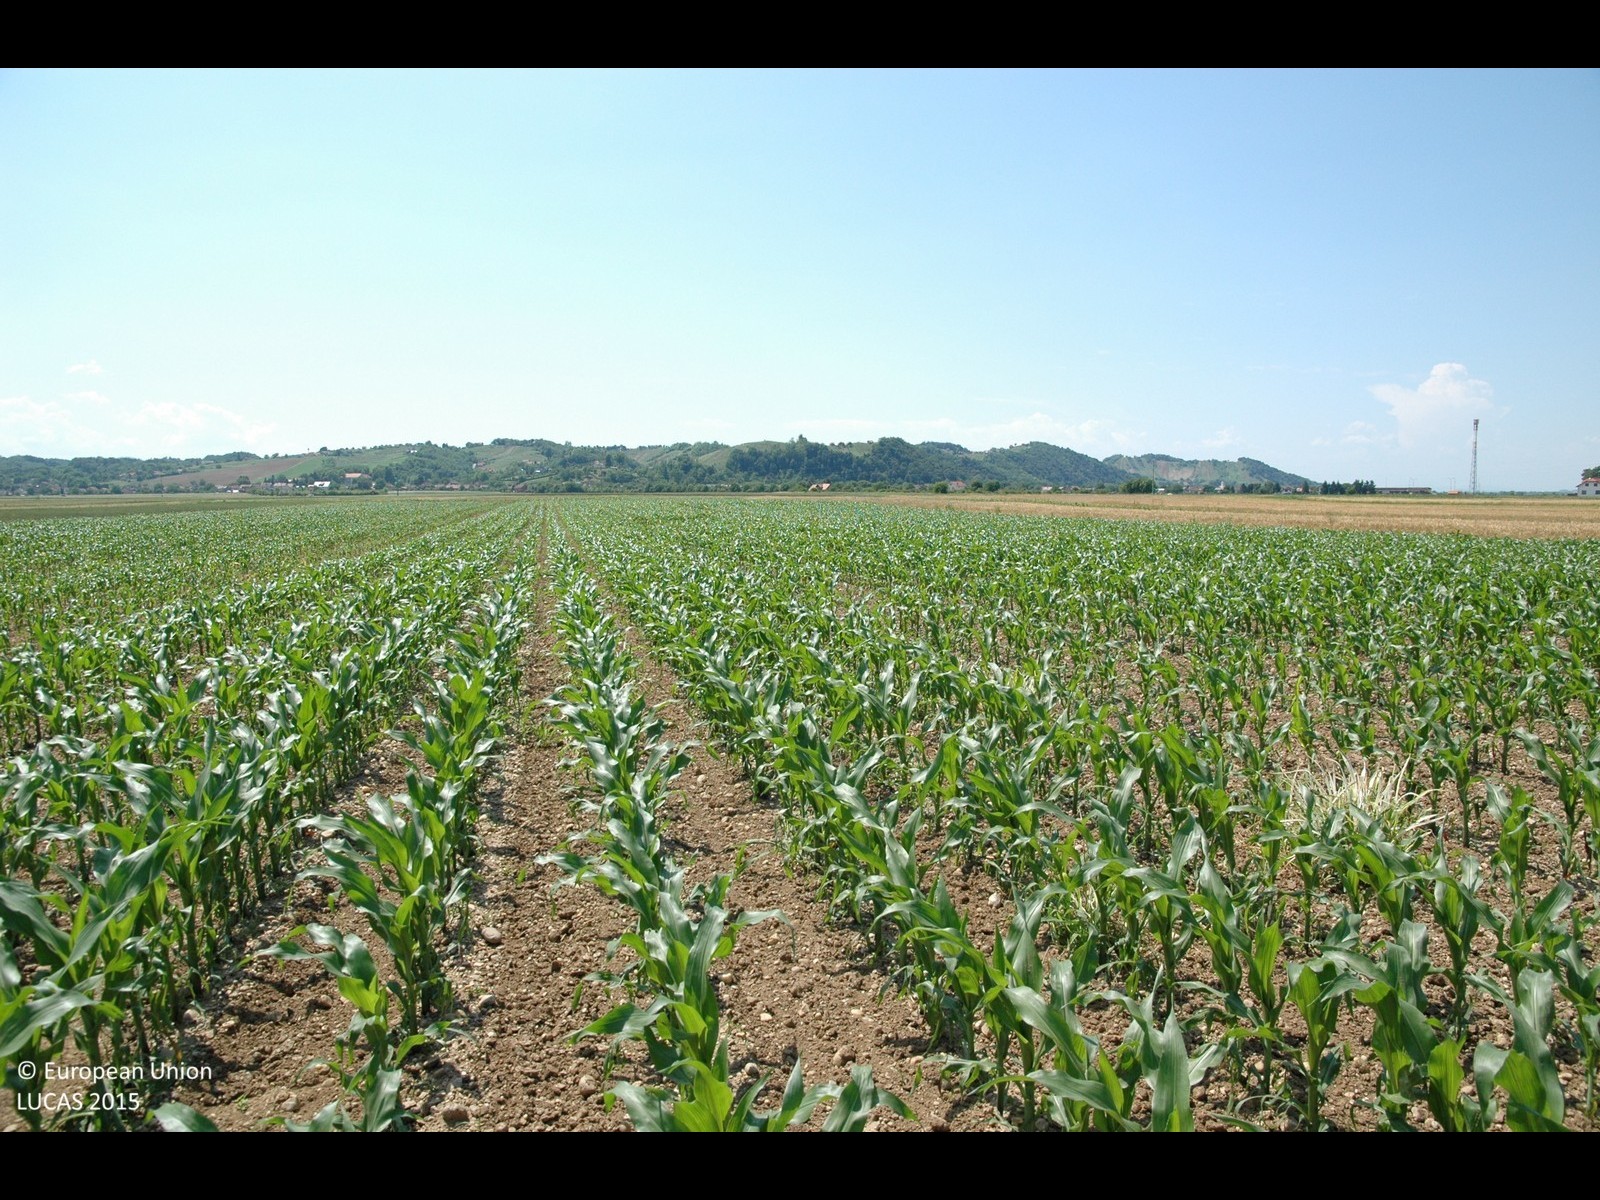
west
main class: Cropland
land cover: Maize
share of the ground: 25 - 50 %
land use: Agriculture (excluding fallow land and kitchen gardens)
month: June
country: HR
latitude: 46.3535
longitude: 16.1726
